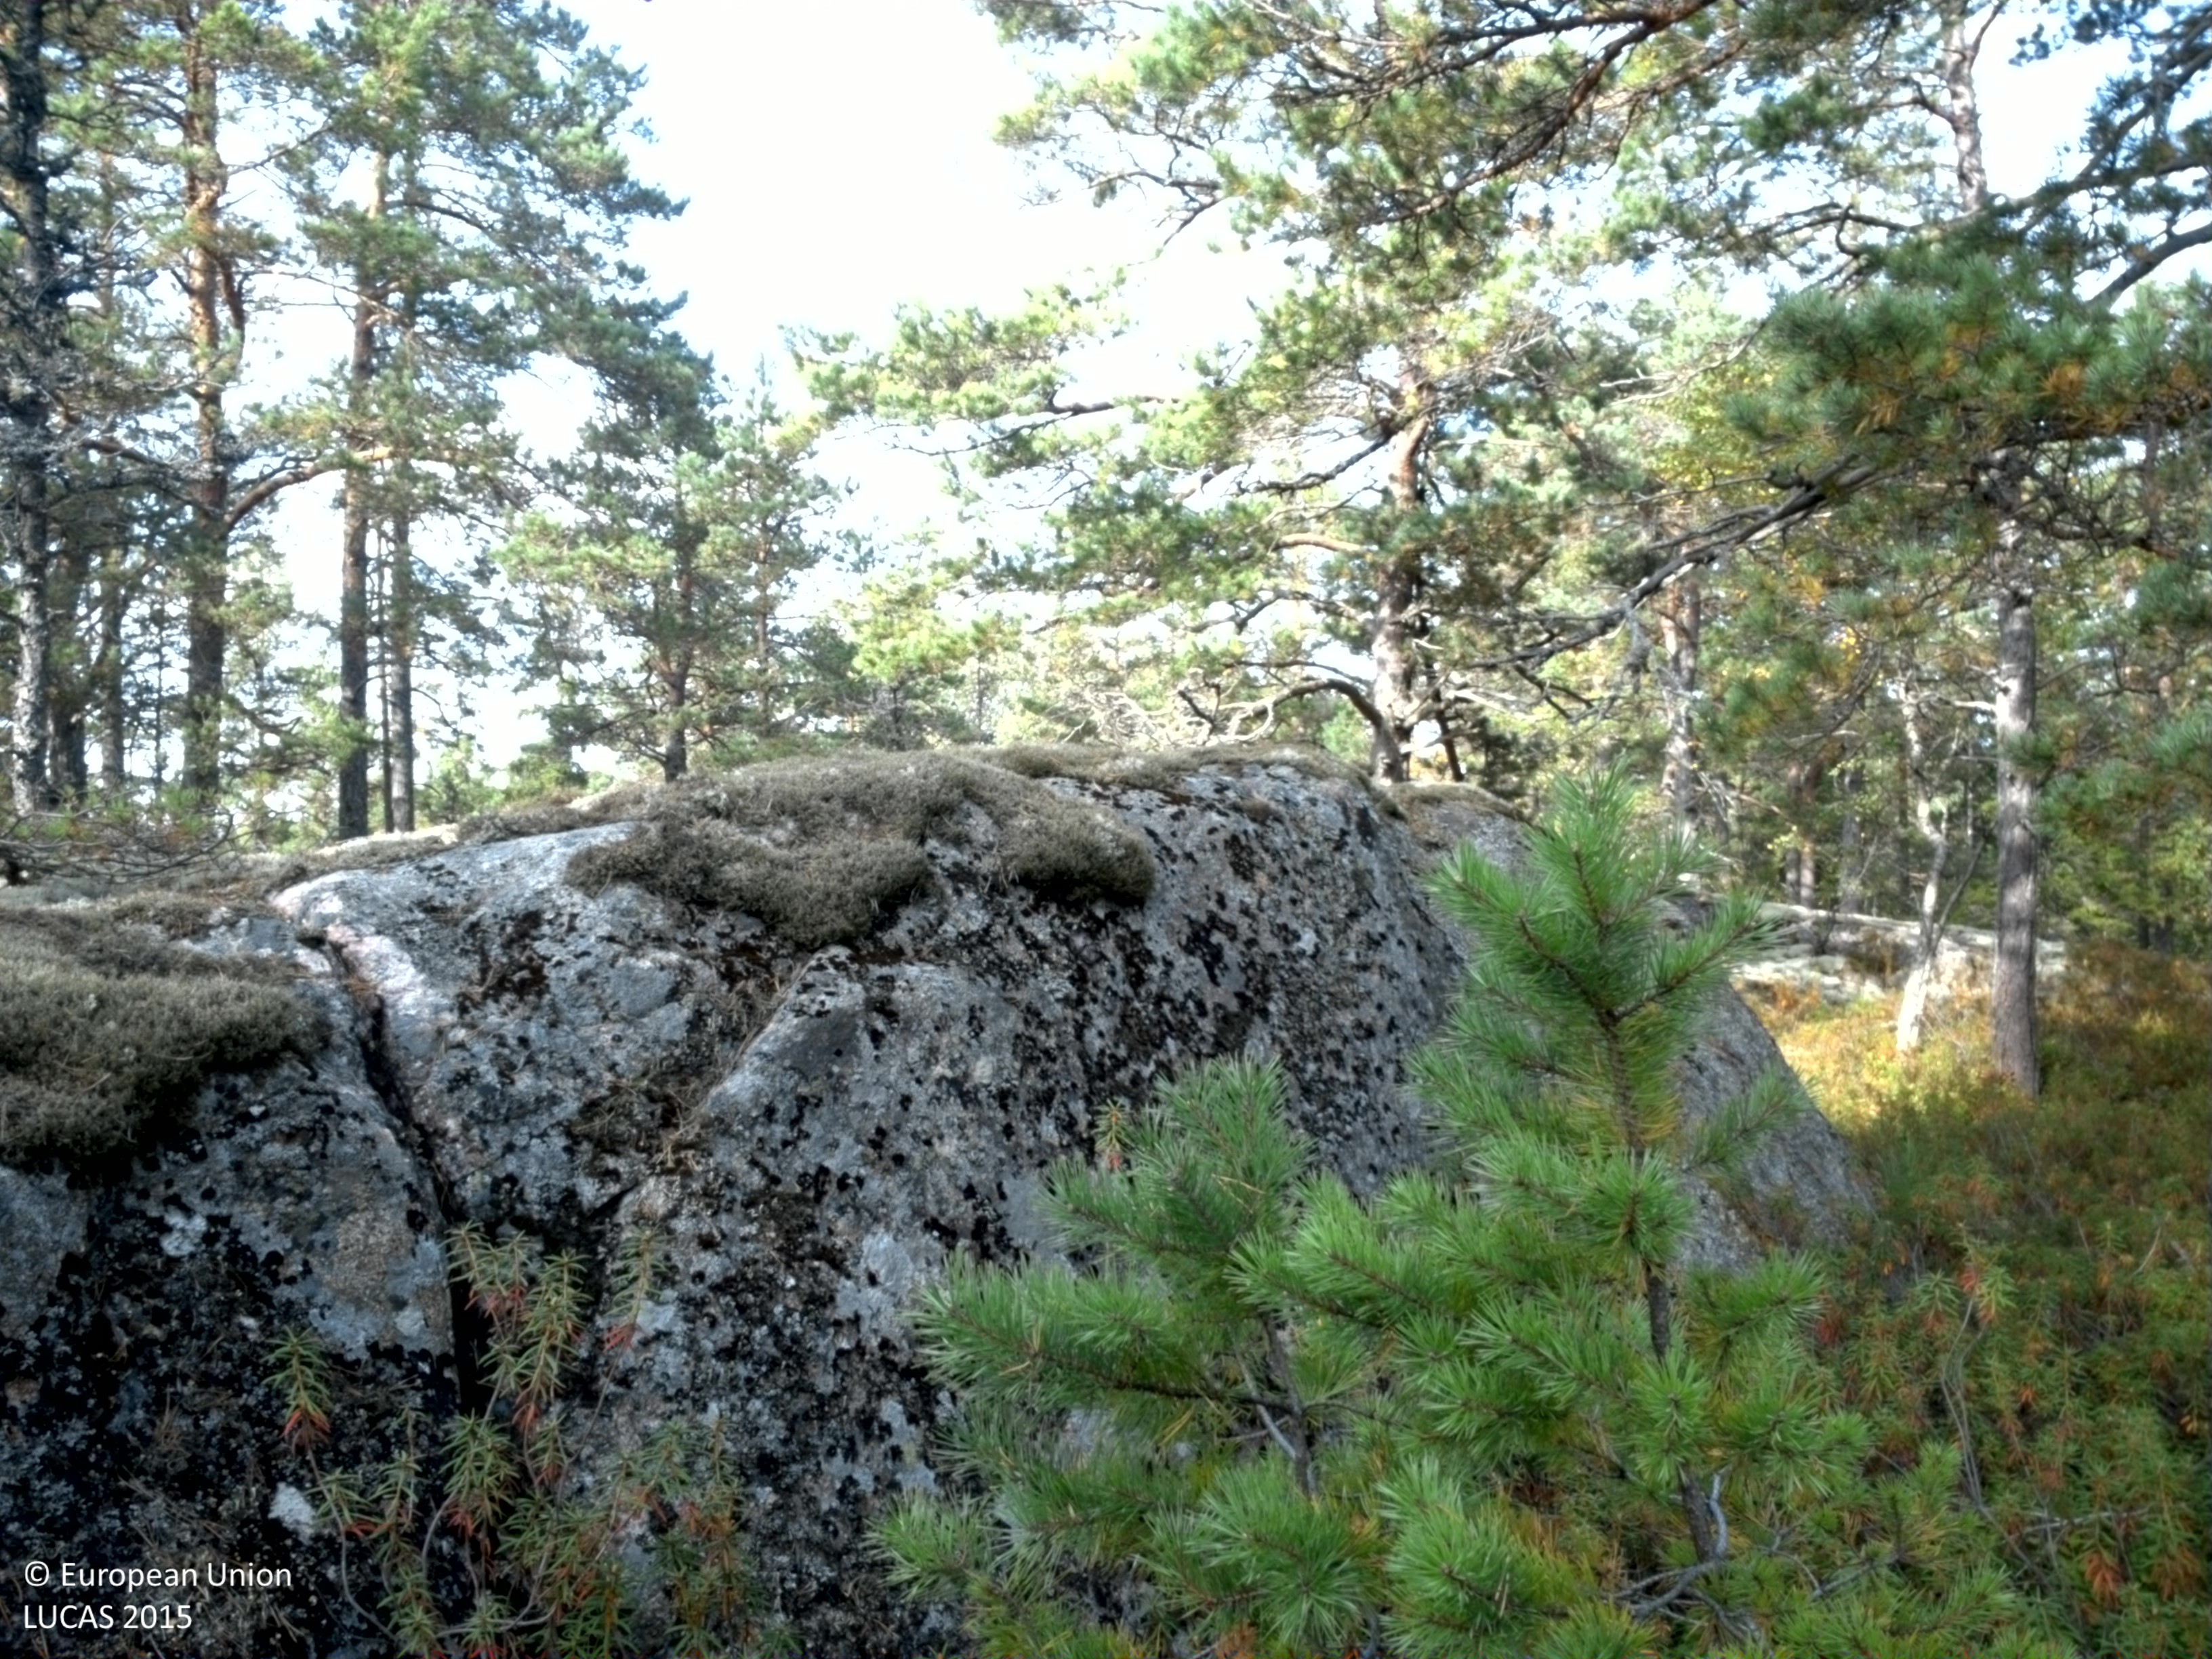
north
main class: Woodland
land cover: Pine dominated coniferous woodland
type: boreal forest
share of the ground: 50 - 75 %
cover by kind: coniferous forest trees 60 %, shrubs 20 %, consolidated bare surface 15 %, lichens and mosses 5 %
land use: Forestry
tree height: > 5 m
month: September
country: SE
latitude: 59.8131
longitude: 18.8262
